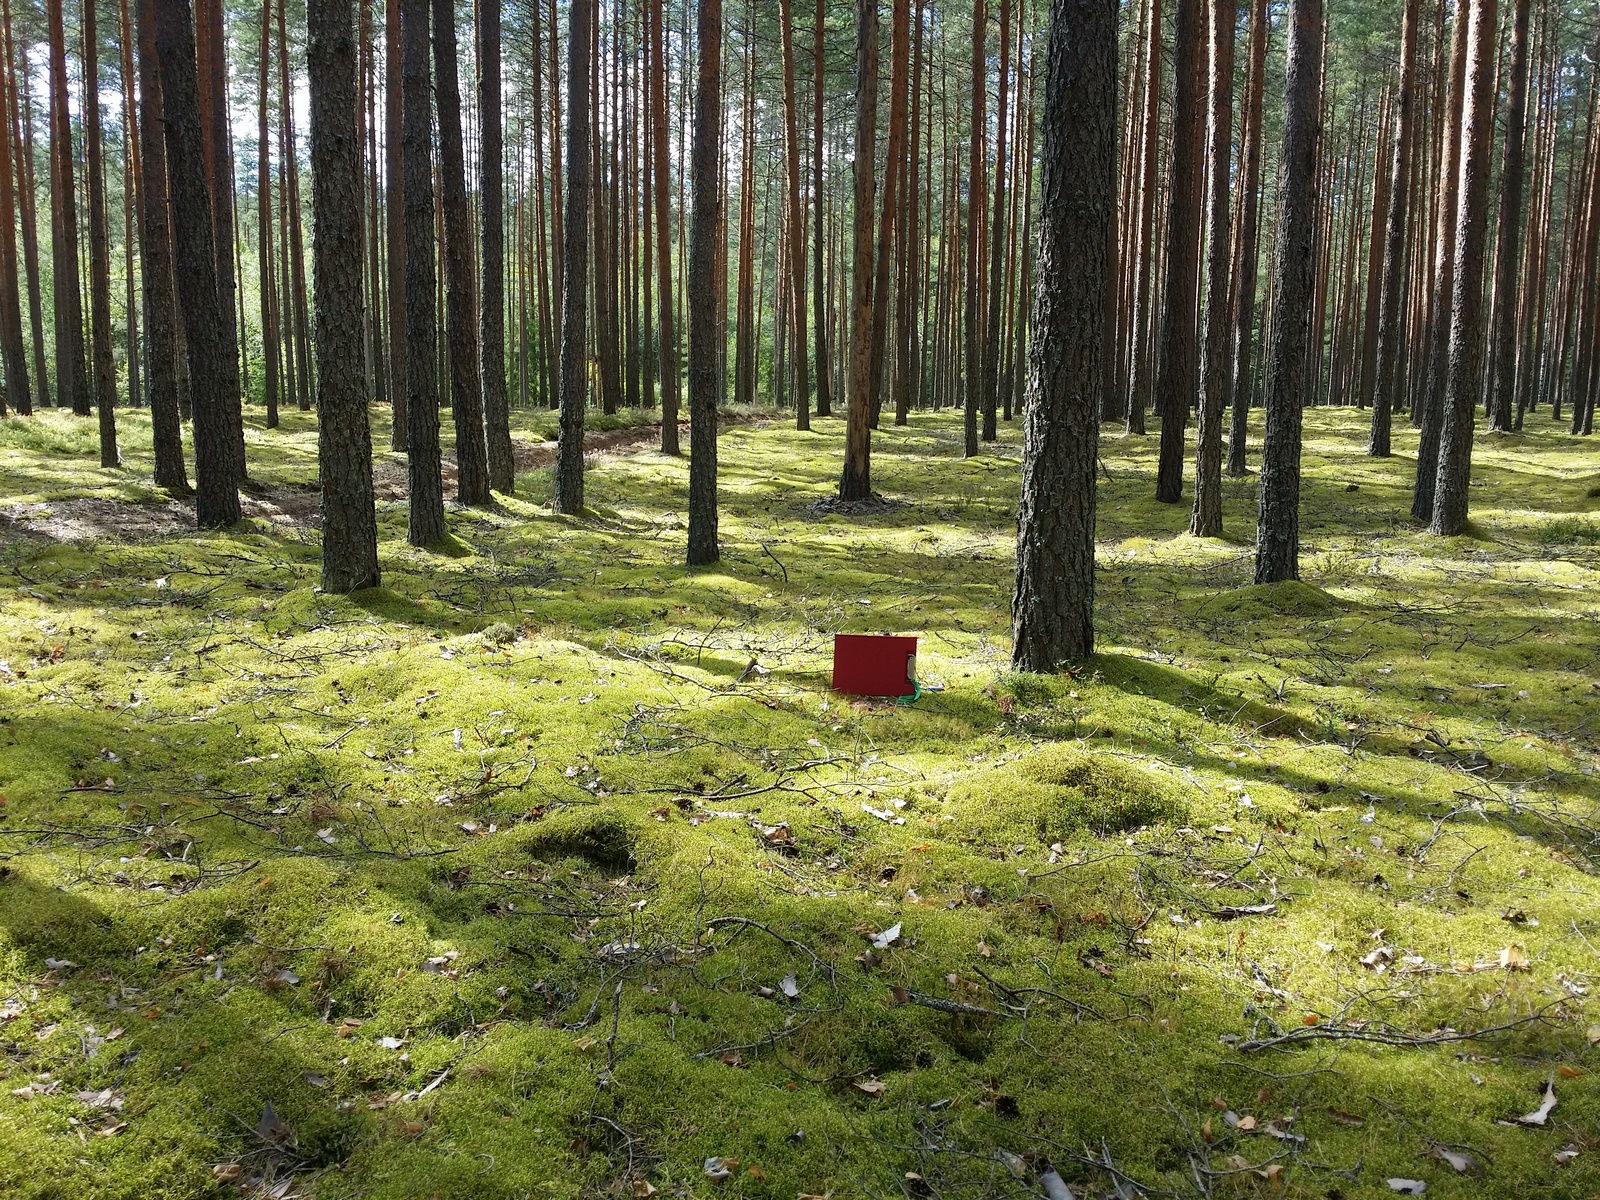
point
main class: Woodland
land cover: Pine dominated coniferous woodland
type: hemiboreal forest and nemoral coniferous forest and mixed broadleaved-coniferous forest
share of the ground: 50 - 75 %
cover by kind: coniferous forest trees 70 %, lichens and mosses 30 %
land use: Forestry
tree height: > 5 m
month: August
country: LV
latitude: 57.3466
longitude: 27.6791
